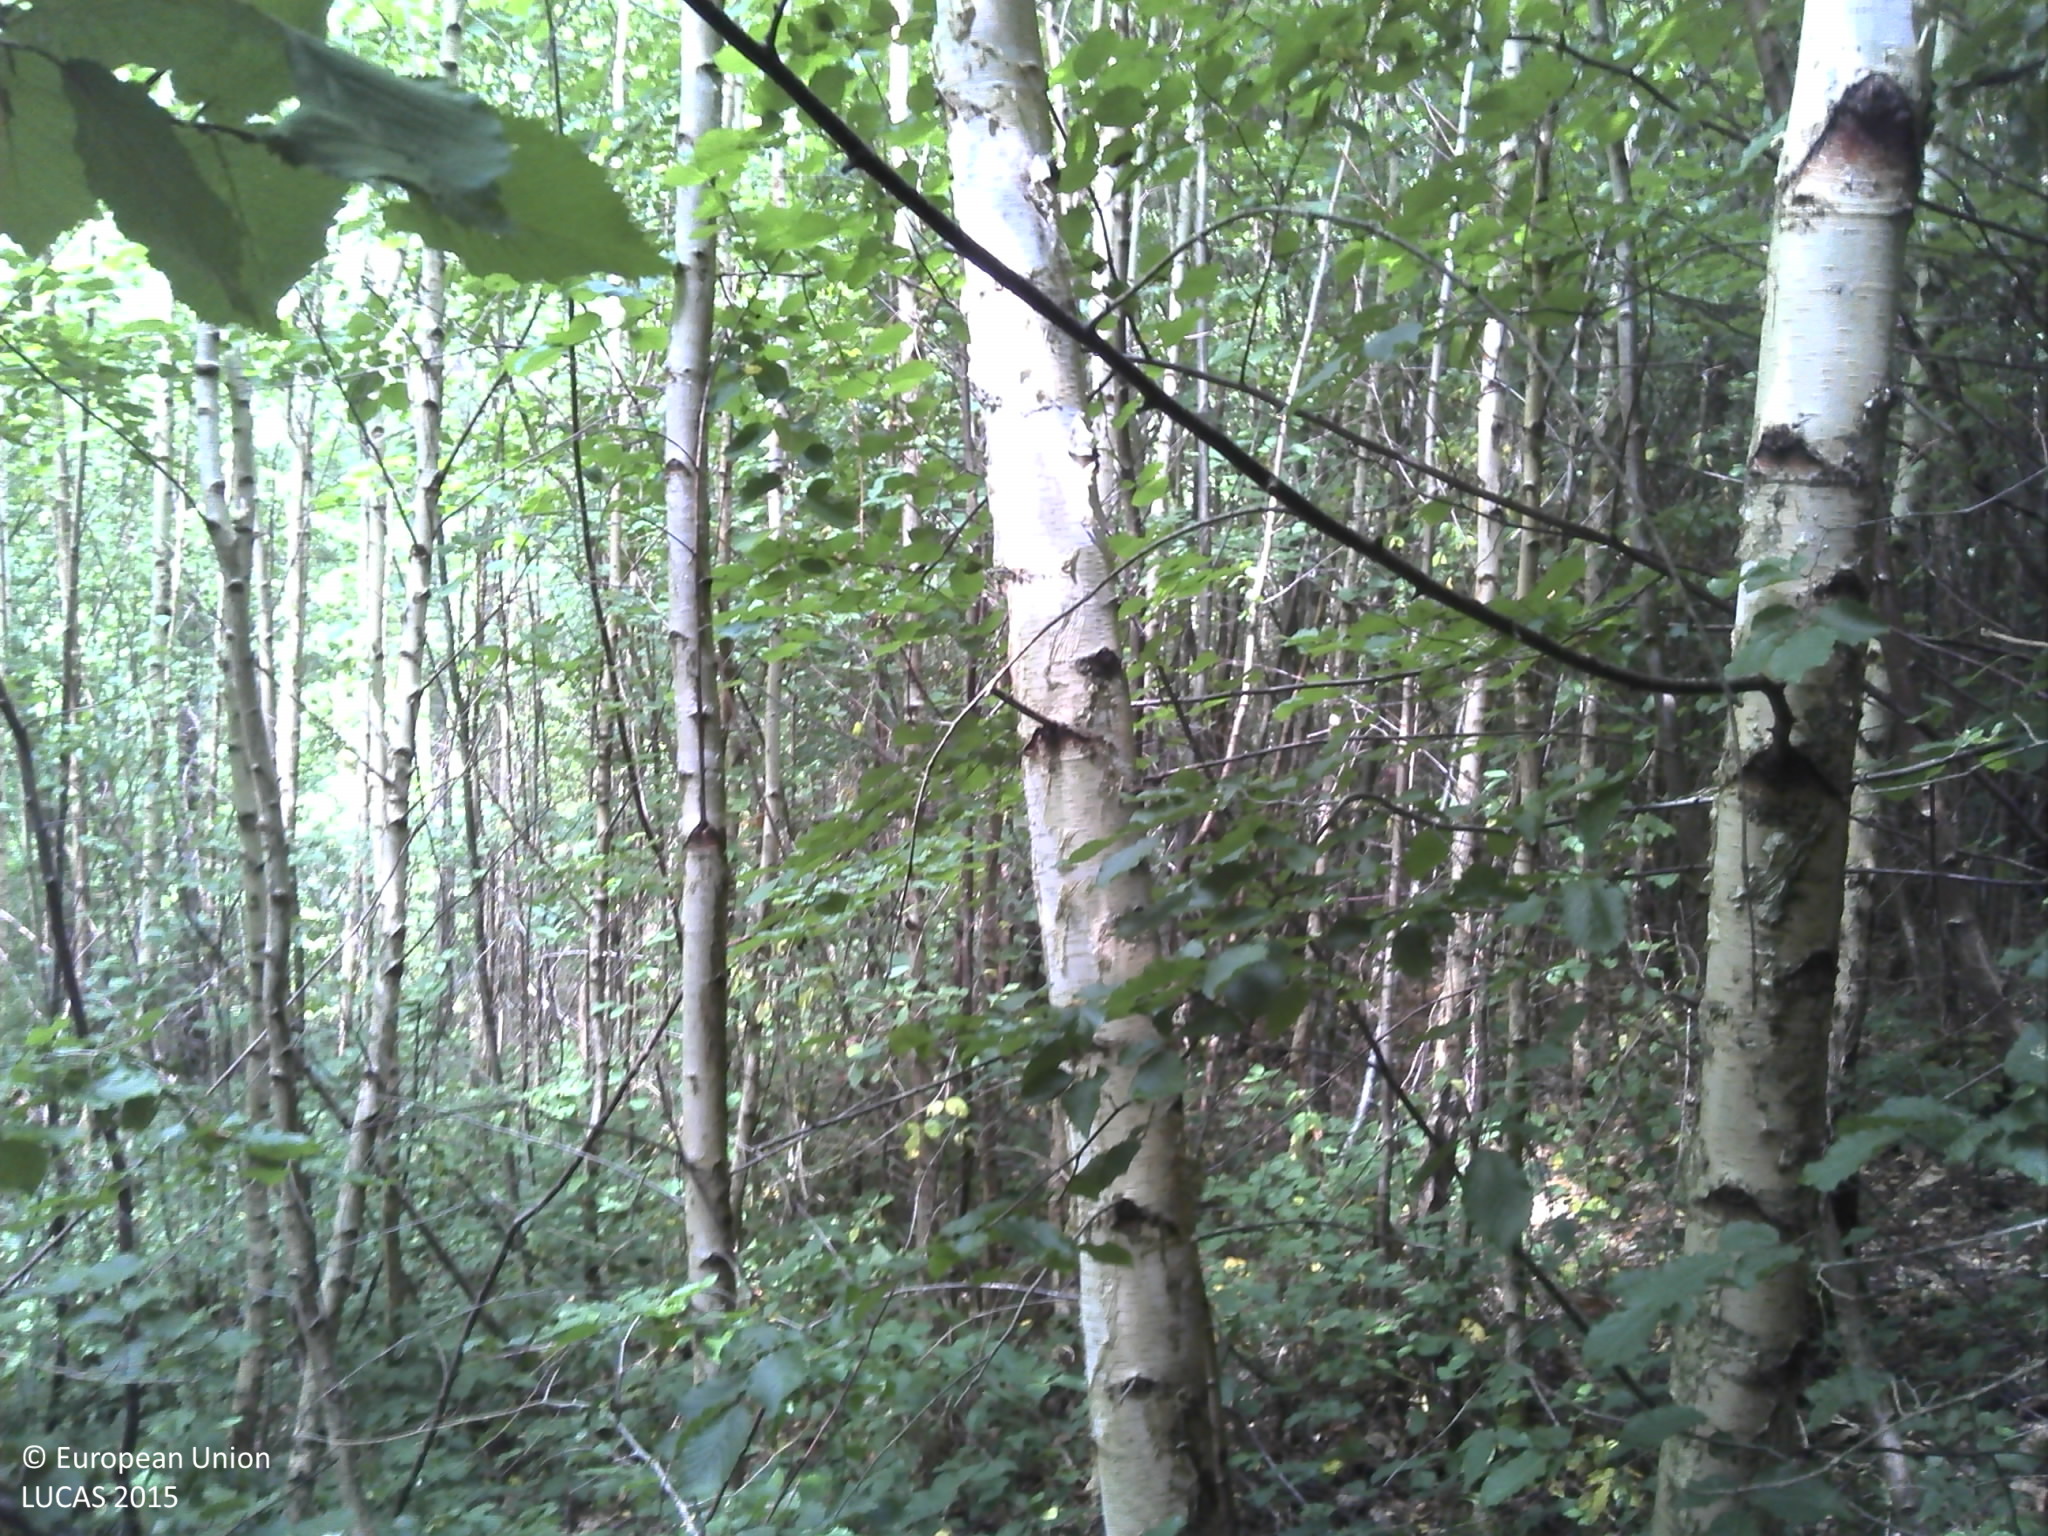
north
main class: Woodland
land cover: Broadleaved woodland
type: beech forest
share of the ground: > 75 %
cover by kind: broadleaved forest trees 70 %, herbaceous plants 20 %, consolidated bare surface 10 %
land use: Forestry
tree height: > 5 m
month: July
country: FR
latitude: 49.3618
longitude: 4.7786
